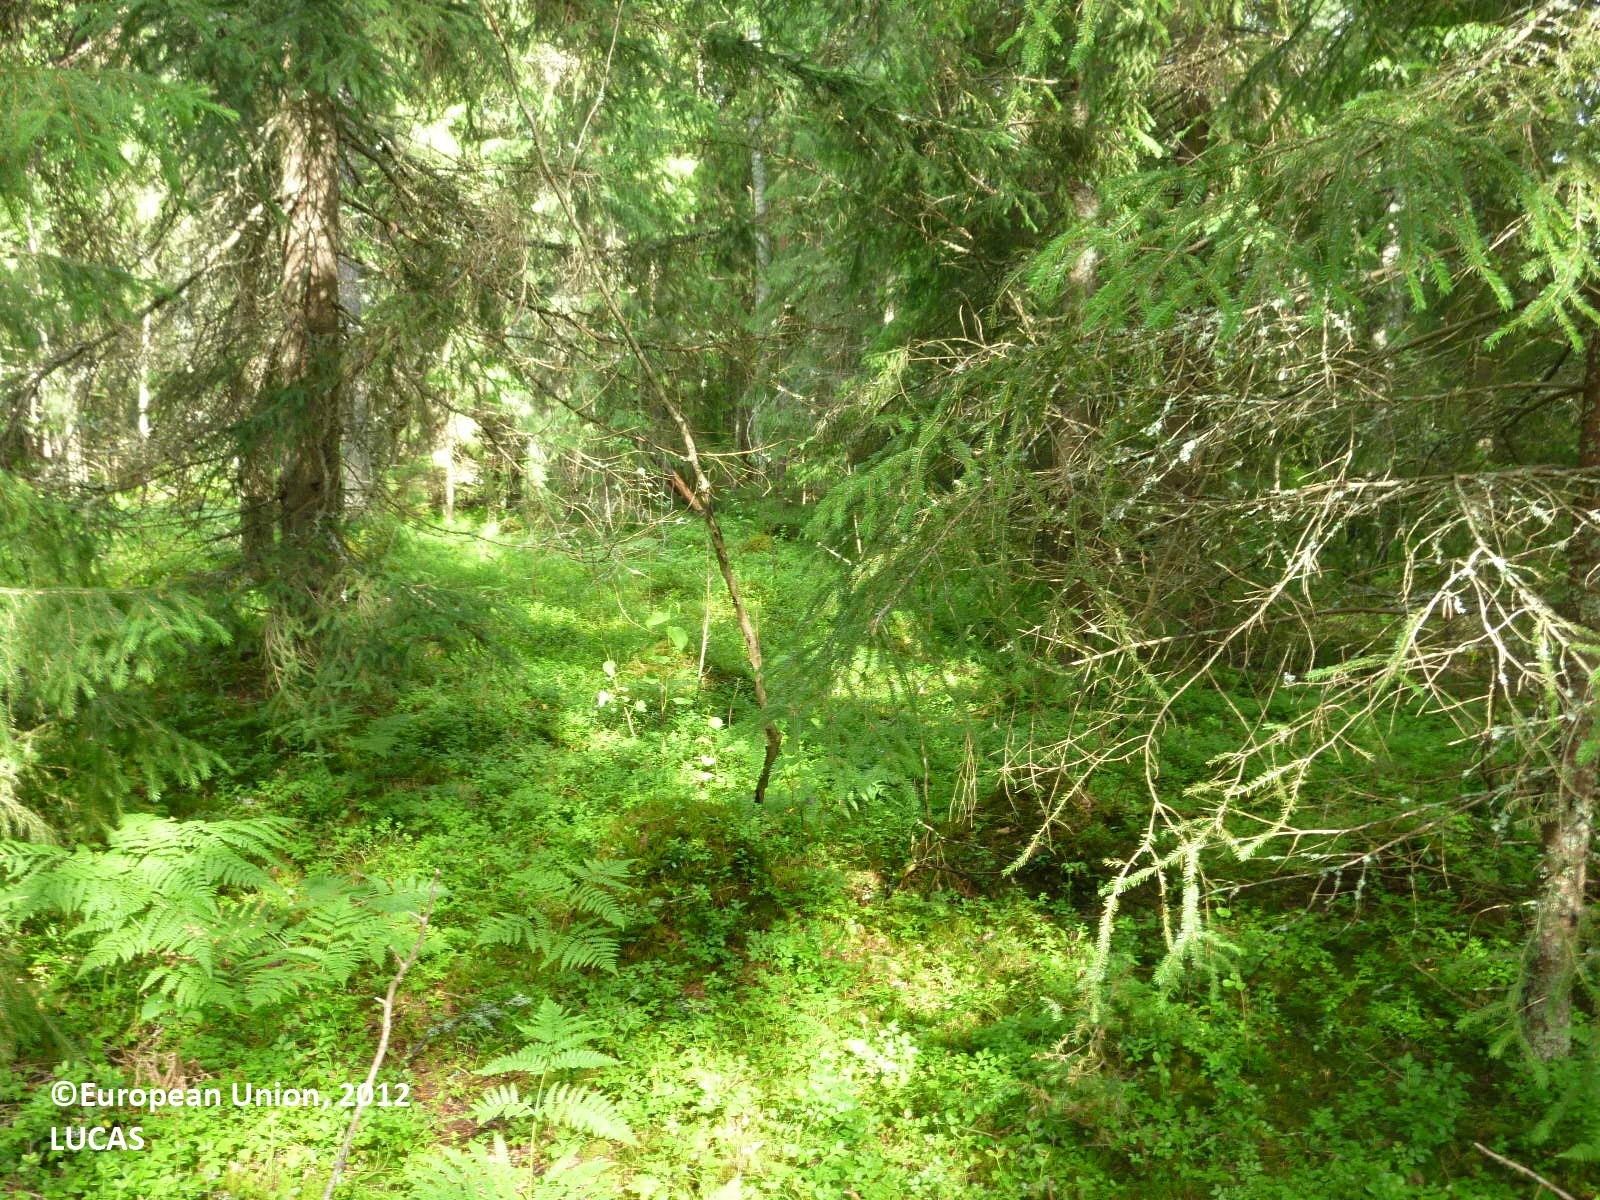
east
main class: Woodland
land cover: Spruce dominated coniferous woodland
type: boreal forest
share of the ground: 50 - 75 %
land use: Forestry
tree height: > 5 m
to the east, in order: Spruce dominated coniferous woodland; Pine dominated coniferous woodland; Pine dominated mixed woodland; Broadleaved woodland; Grass margins; Artificial constructions in urban areas; Grass margins; Apple fruit; Grass margins; Potatoes; Grass margins; Abandoned hedges; Temporary grasslands
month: June
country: FI
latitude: 60.2671
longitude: 22.6366
